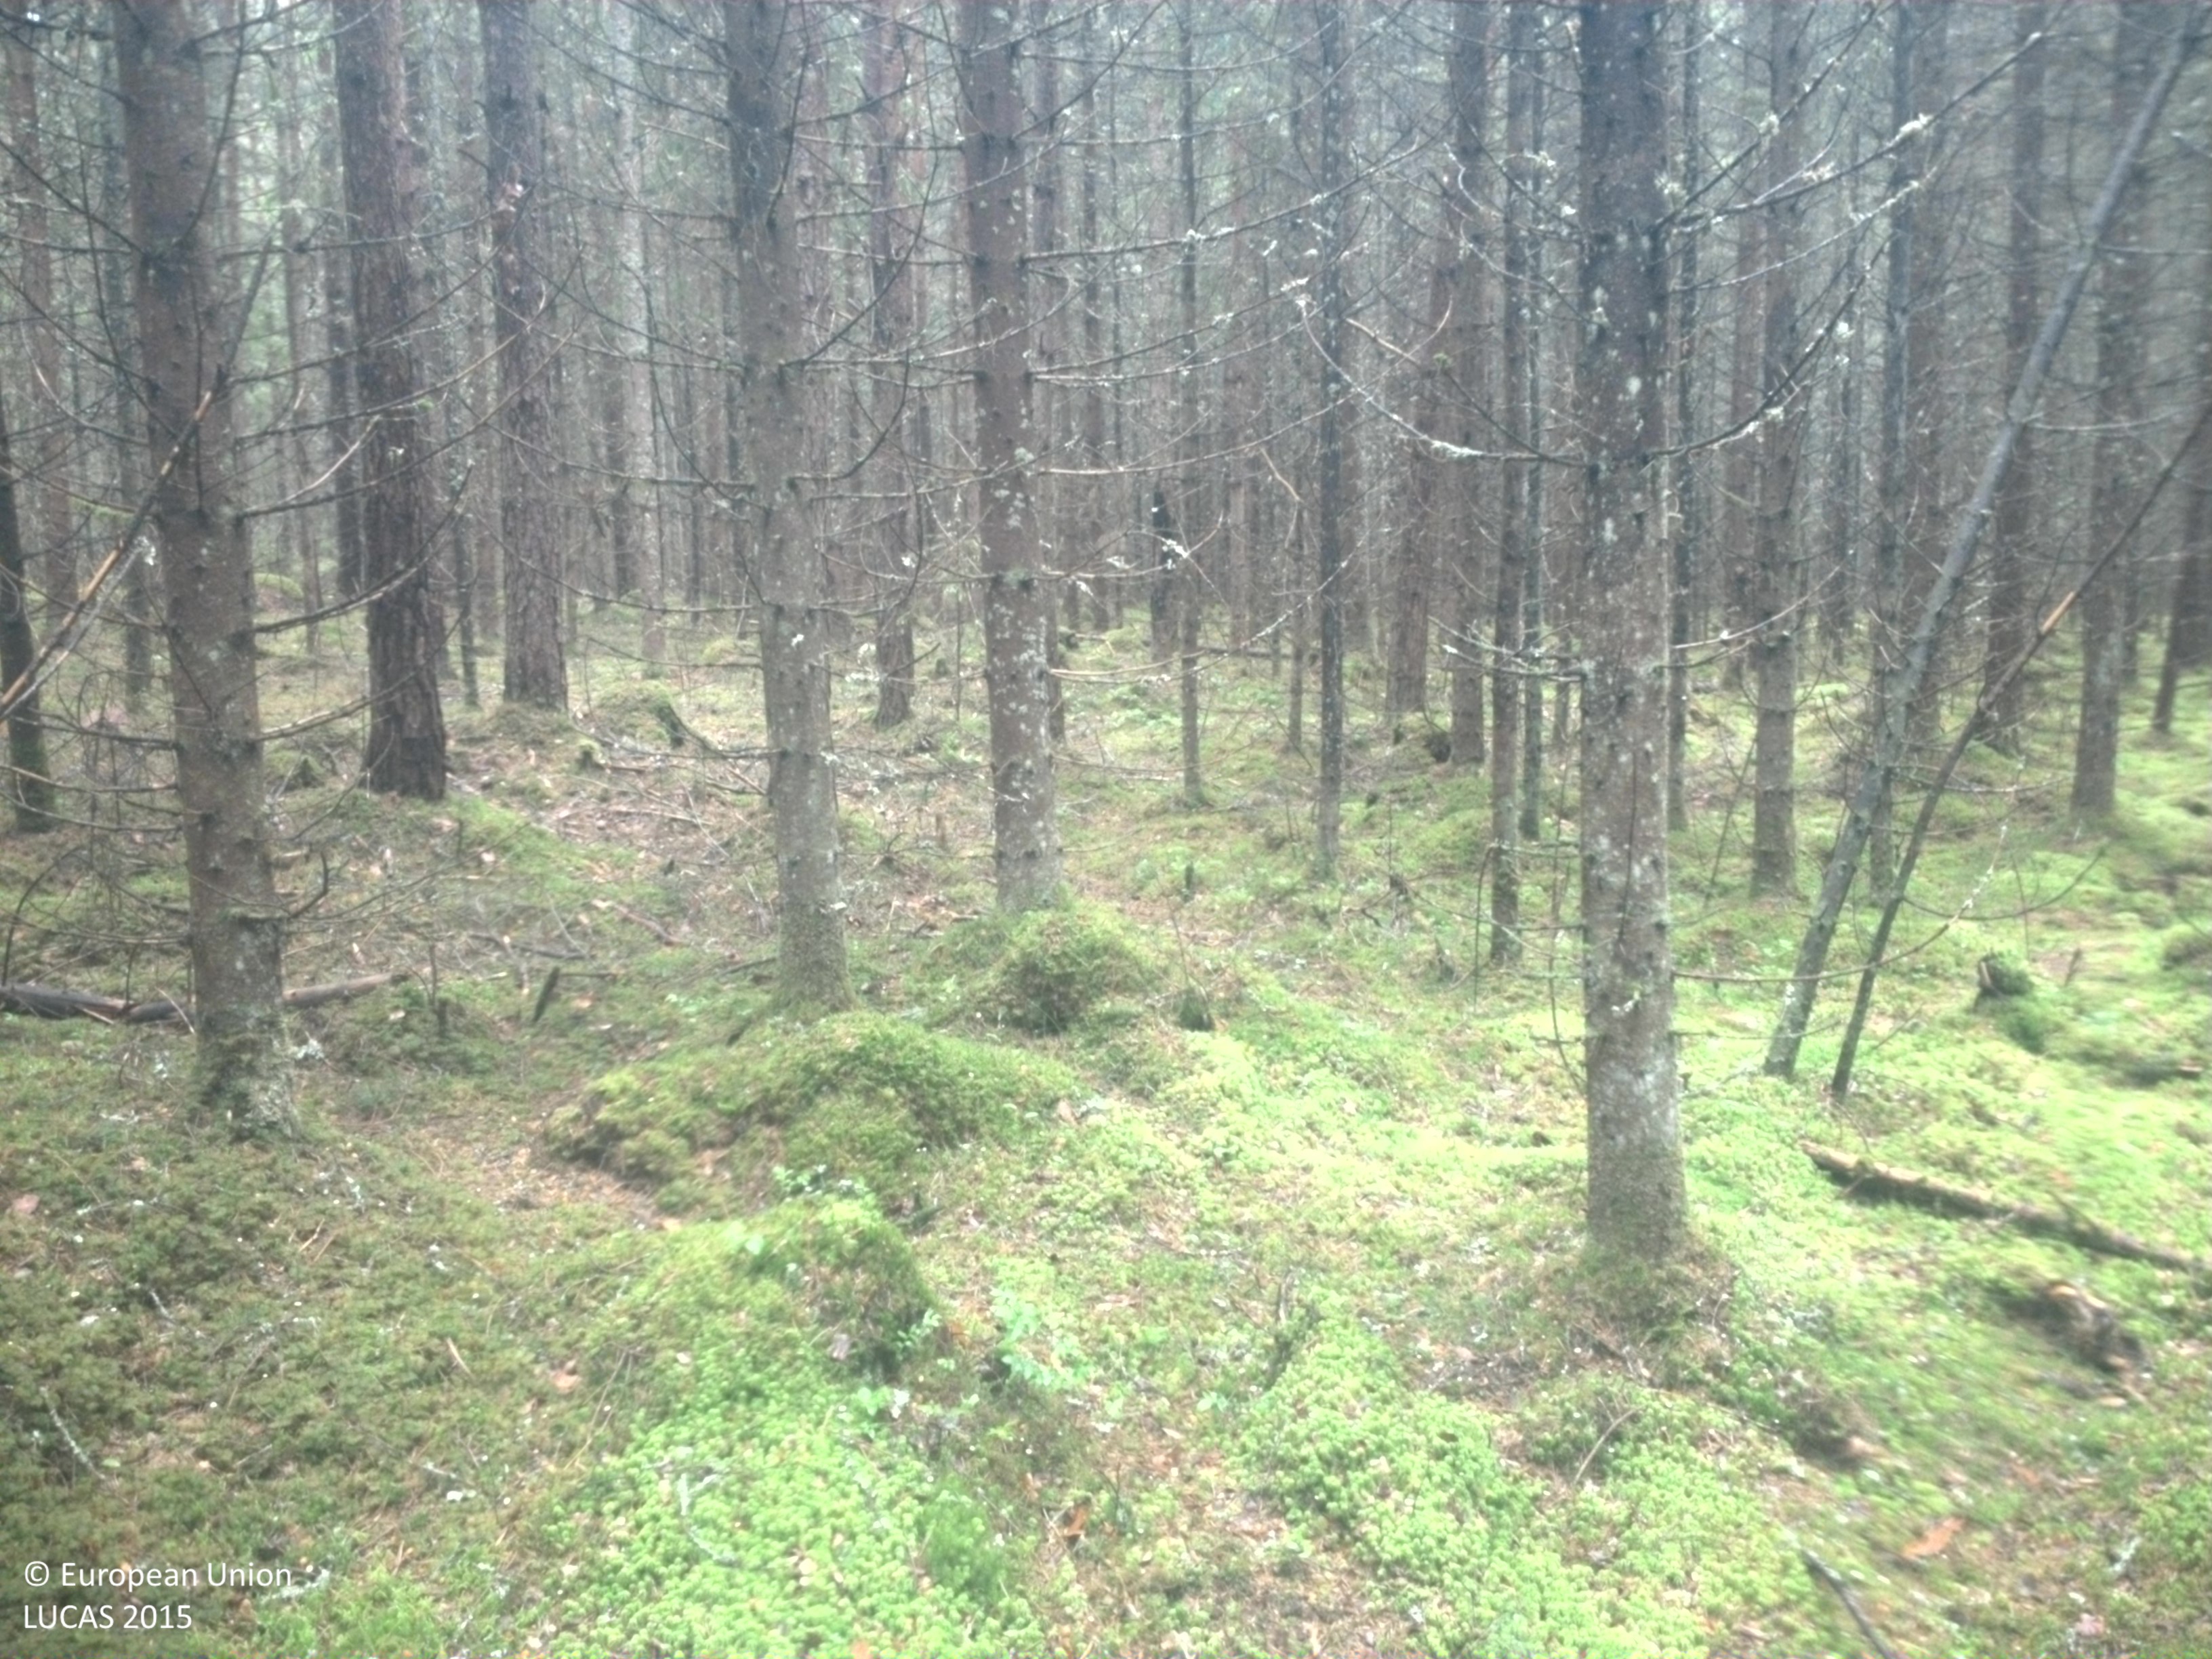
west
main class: Woodland
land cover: Spruce dominated mixed woodland
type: boreal forest
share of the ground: > 75 %
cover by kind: coniferous forest trees 60 %, broadleaved forest trees 25 %, lichens and mosses 15 %
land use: Forestry
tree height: > 5 m
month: June
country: SE
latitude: 59.4254
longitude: 14.4504
